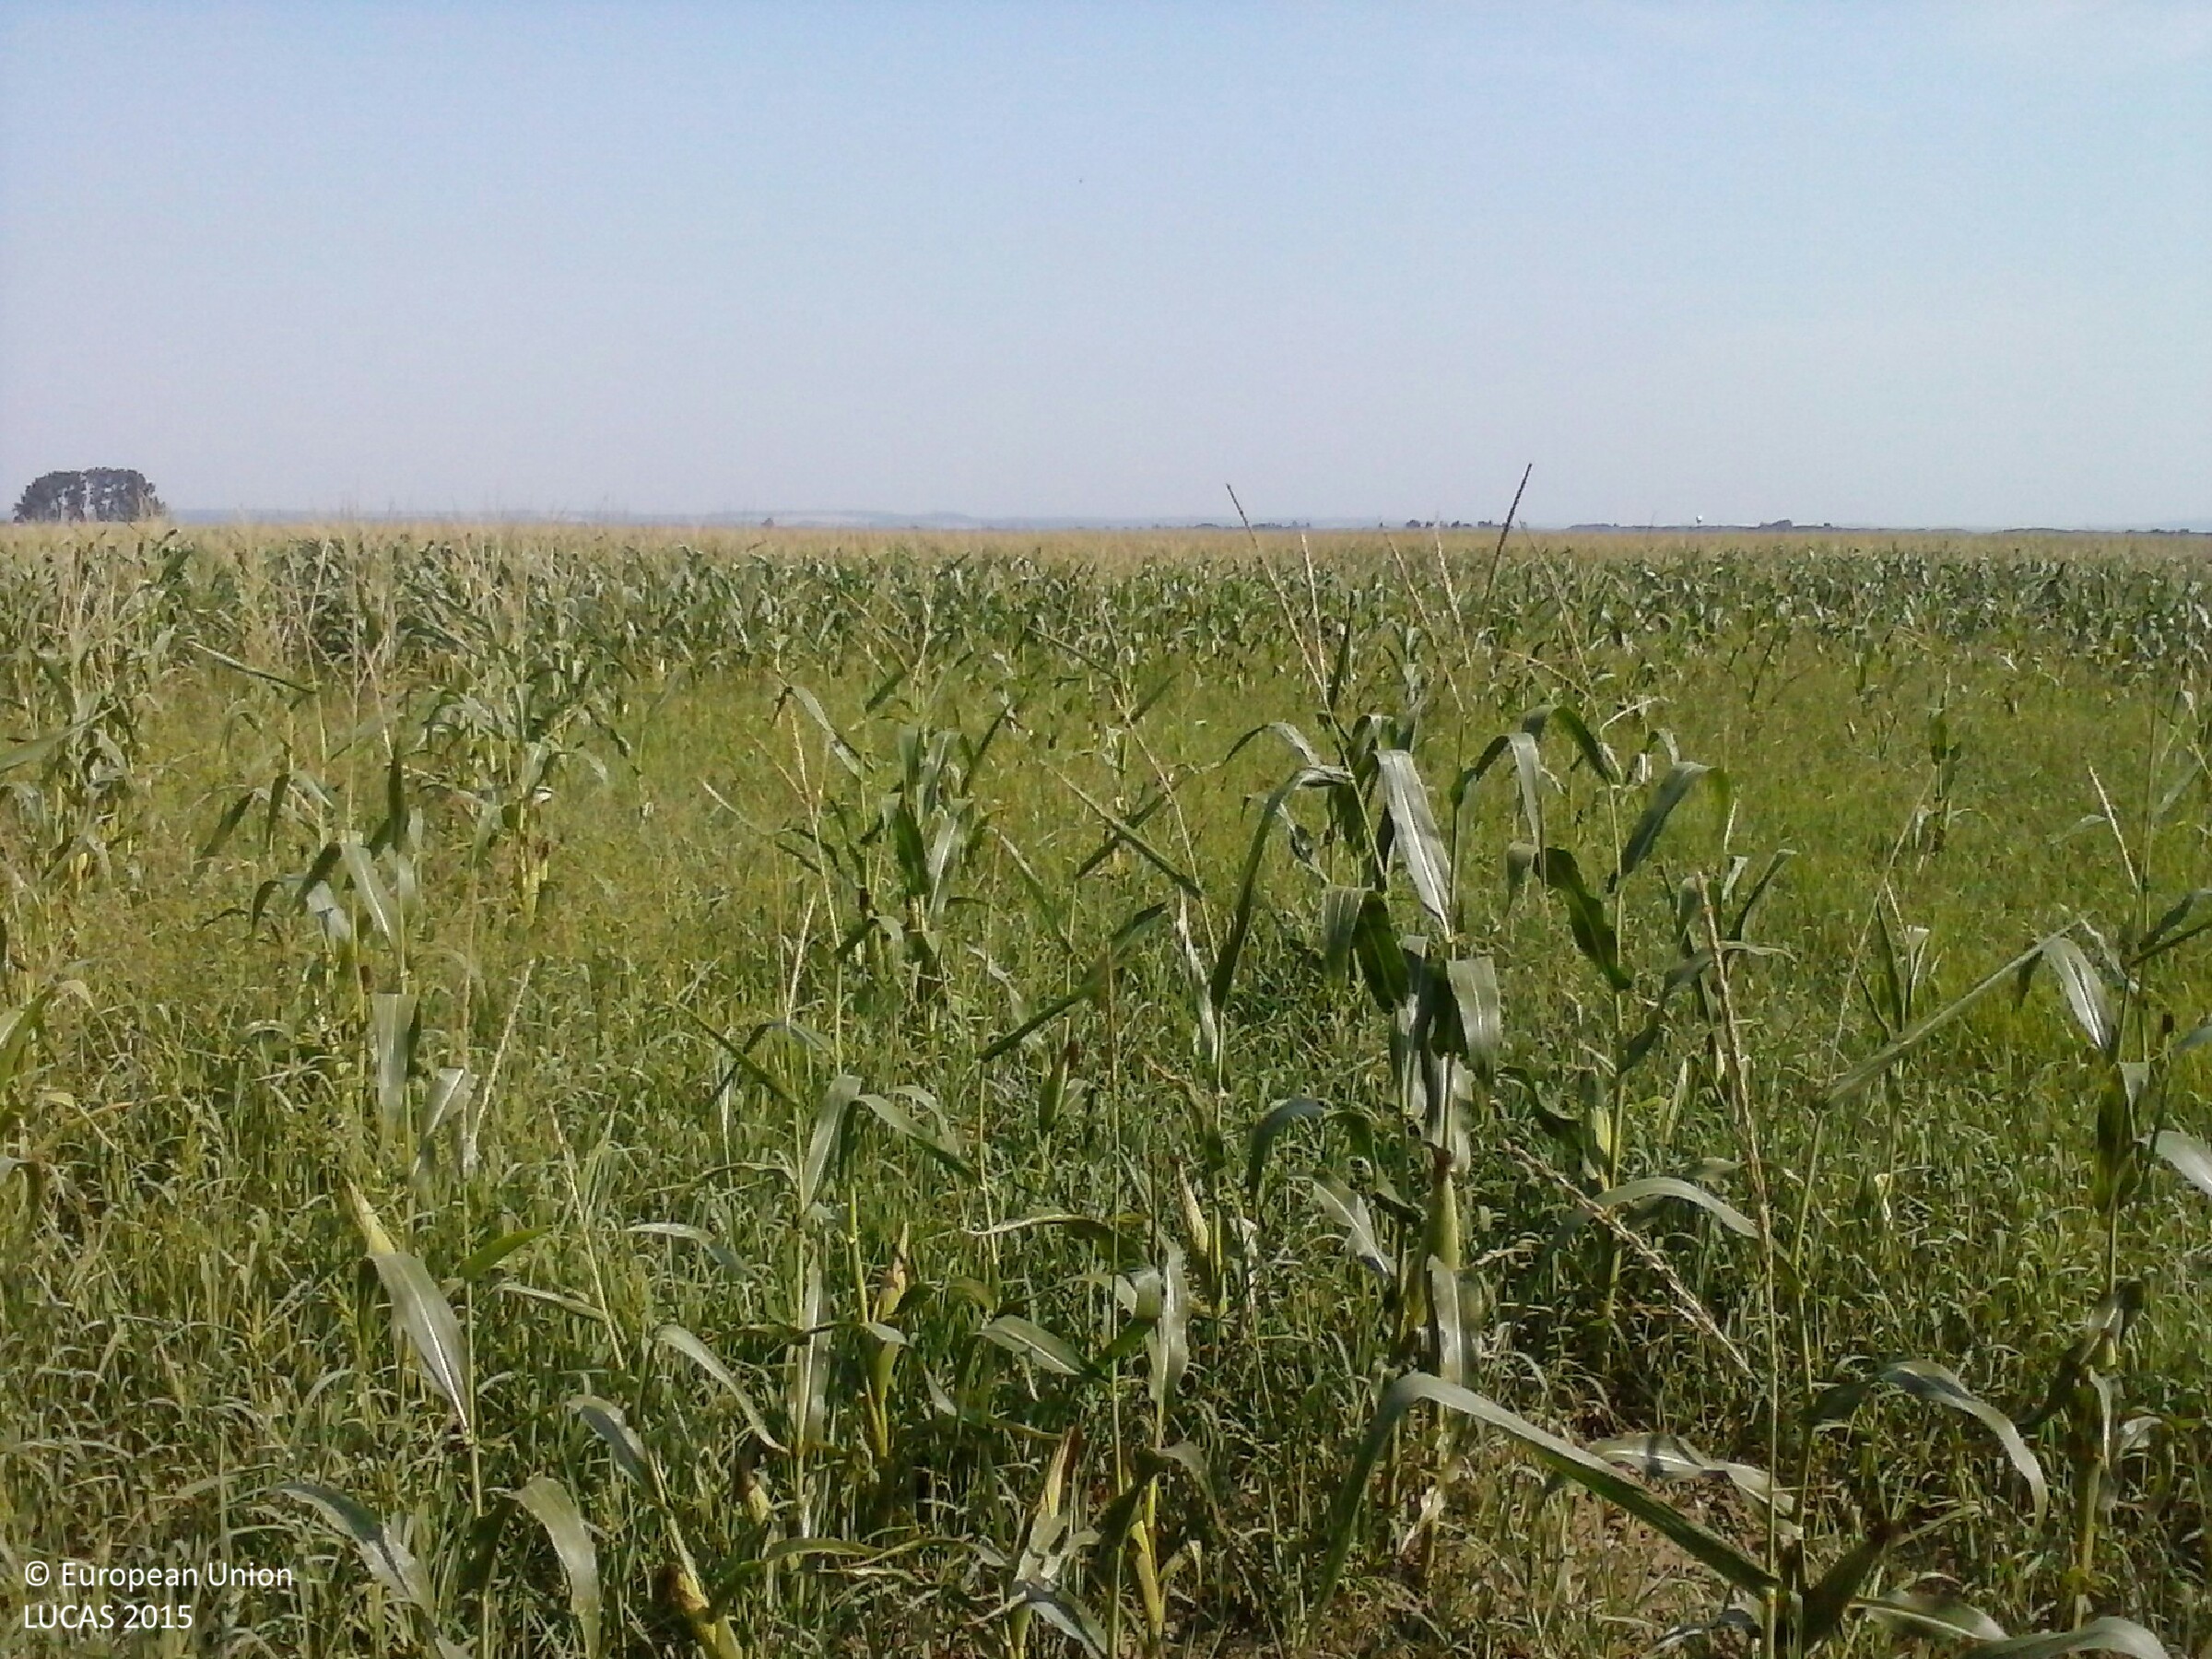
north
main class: Cropland
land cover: Maize
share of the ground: 25 - 50 %
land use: Agriculture (excluding fallow land and kitchen gardens)
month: August
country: HU
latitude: 45.9850
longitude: 17.9184
